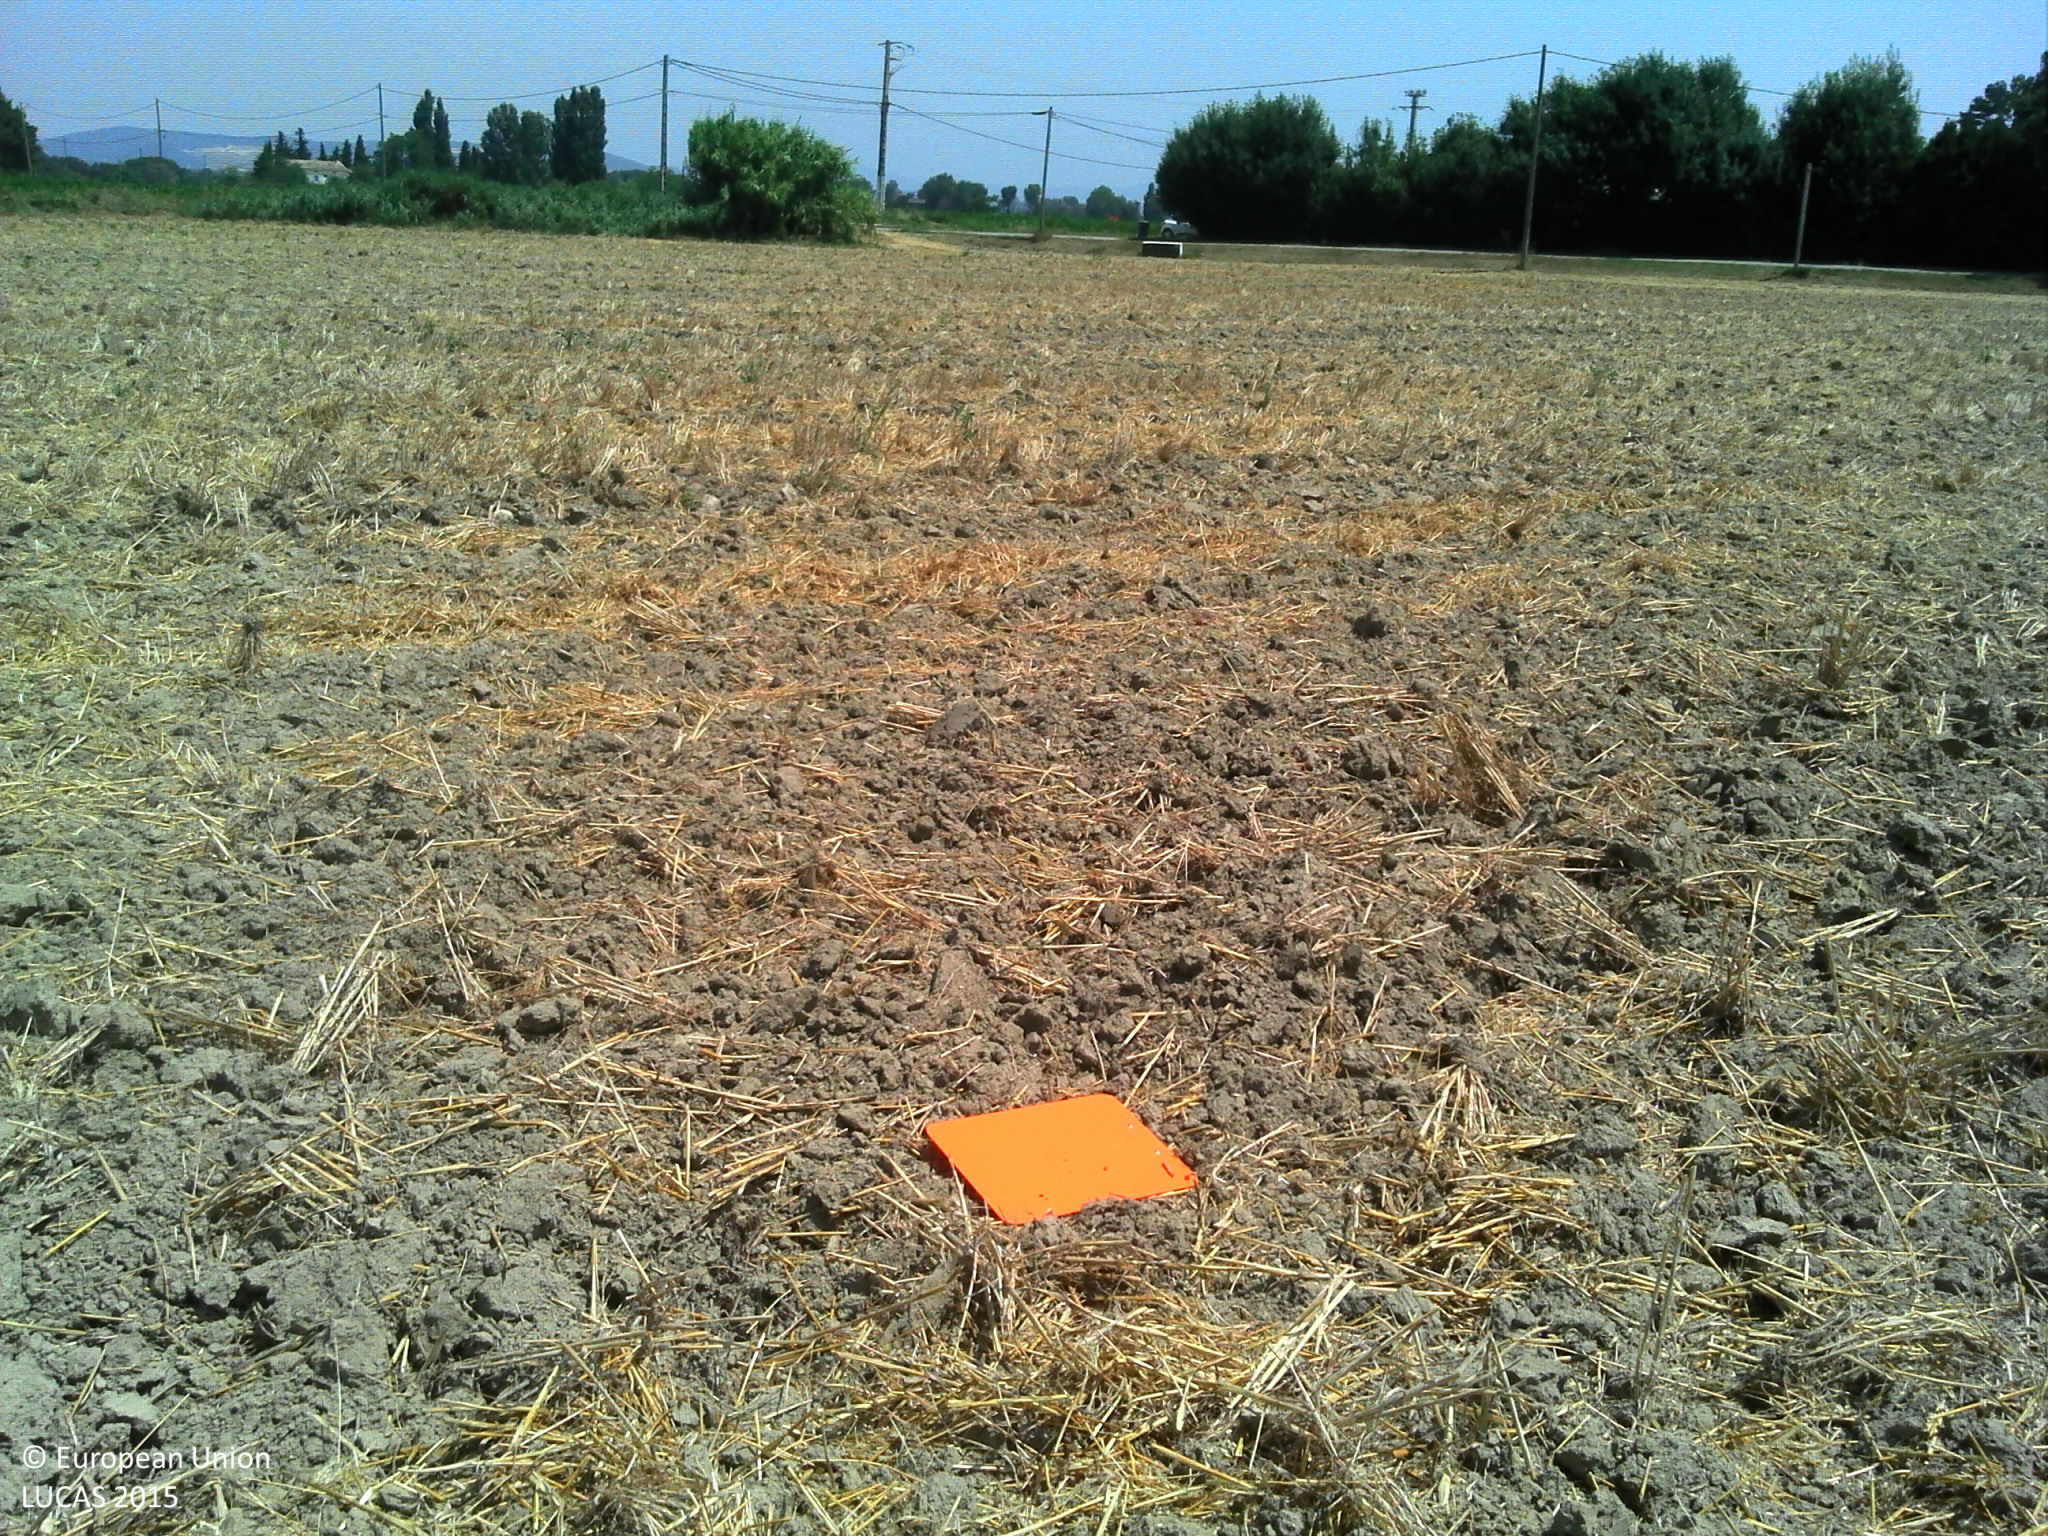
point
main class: Cropland
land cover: Barley
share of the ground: > 75 %
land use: Agriculture (excluding fallow land and kitchen gardens)
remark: Harvested field
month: July
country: FR
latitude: 44.3944
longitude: 4.6715
